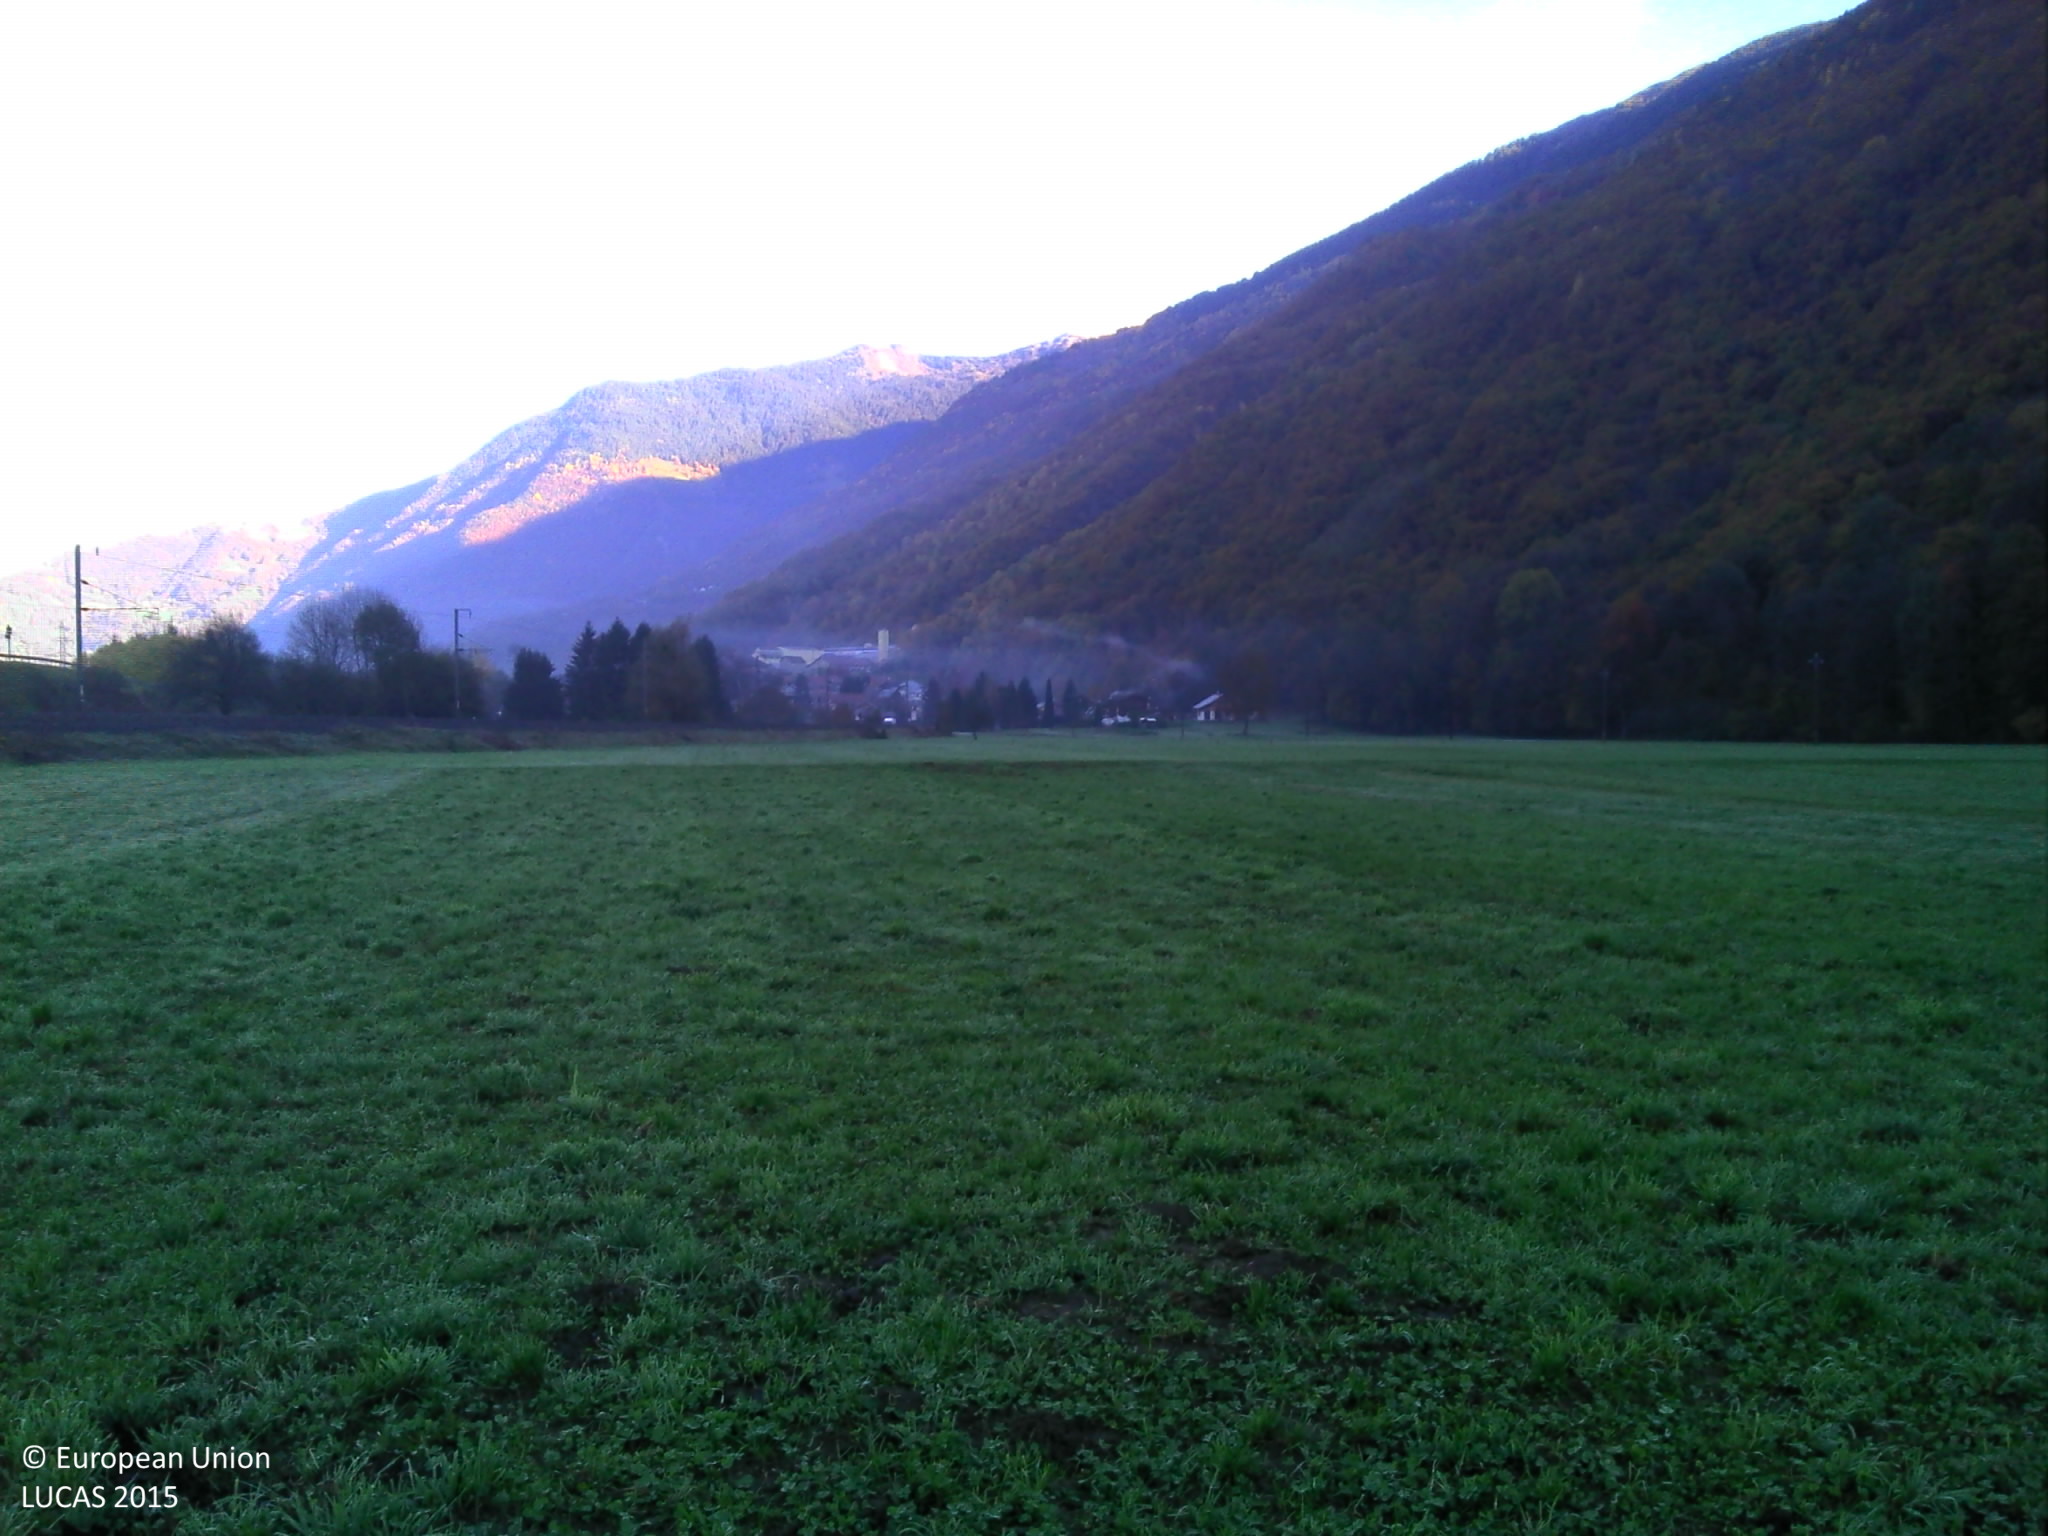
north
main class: Grassland
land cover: Grassland without tree/shrub cover
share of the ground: > 75 %
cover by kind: herbaceous plants 100 %
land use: Agriculture (excluding fallow land and kitchen gardens)
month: October
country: FR
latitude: 45.6072
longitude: 6.4527
